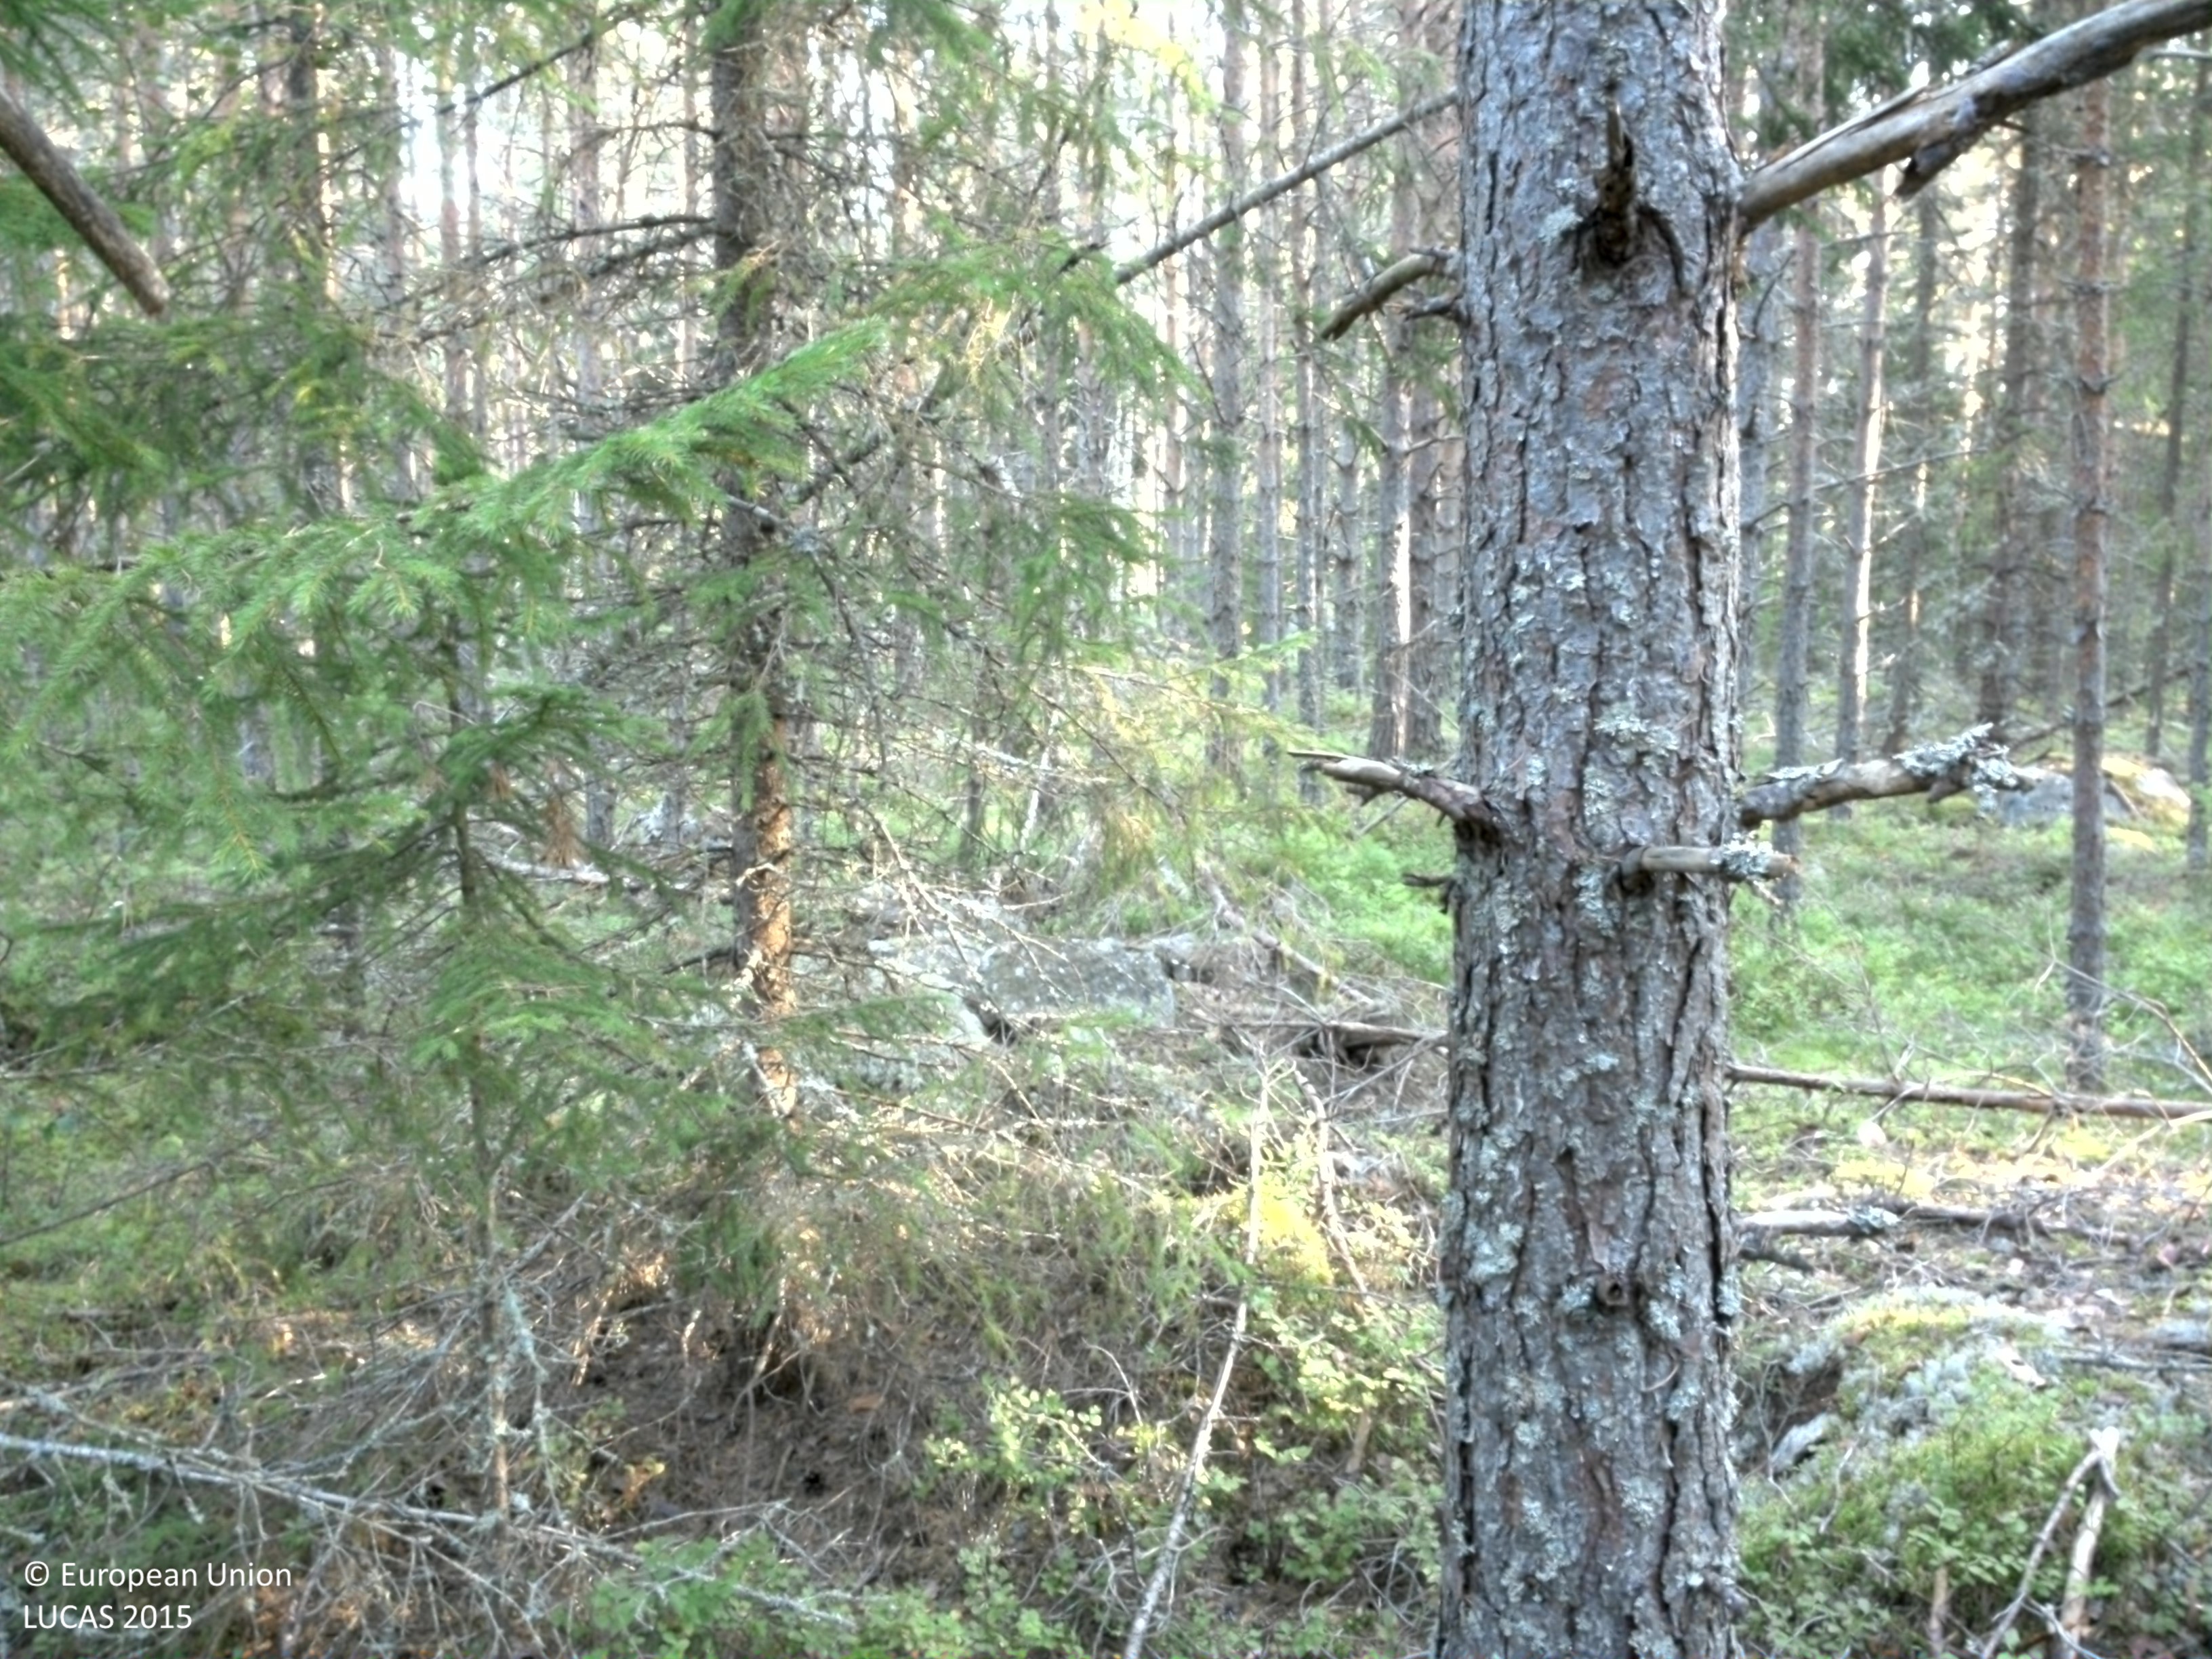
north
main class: Woodland
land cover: Pine dominated coniferous woodland
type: boreal forest
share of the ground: > 75 %
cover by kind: coniferous forest trees 75 %, lichens and mosses 15 %, shrubs 10 %
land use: Forestry
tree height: > 5 m
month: August
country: SE
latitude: 59.7287
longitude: 15.9843
